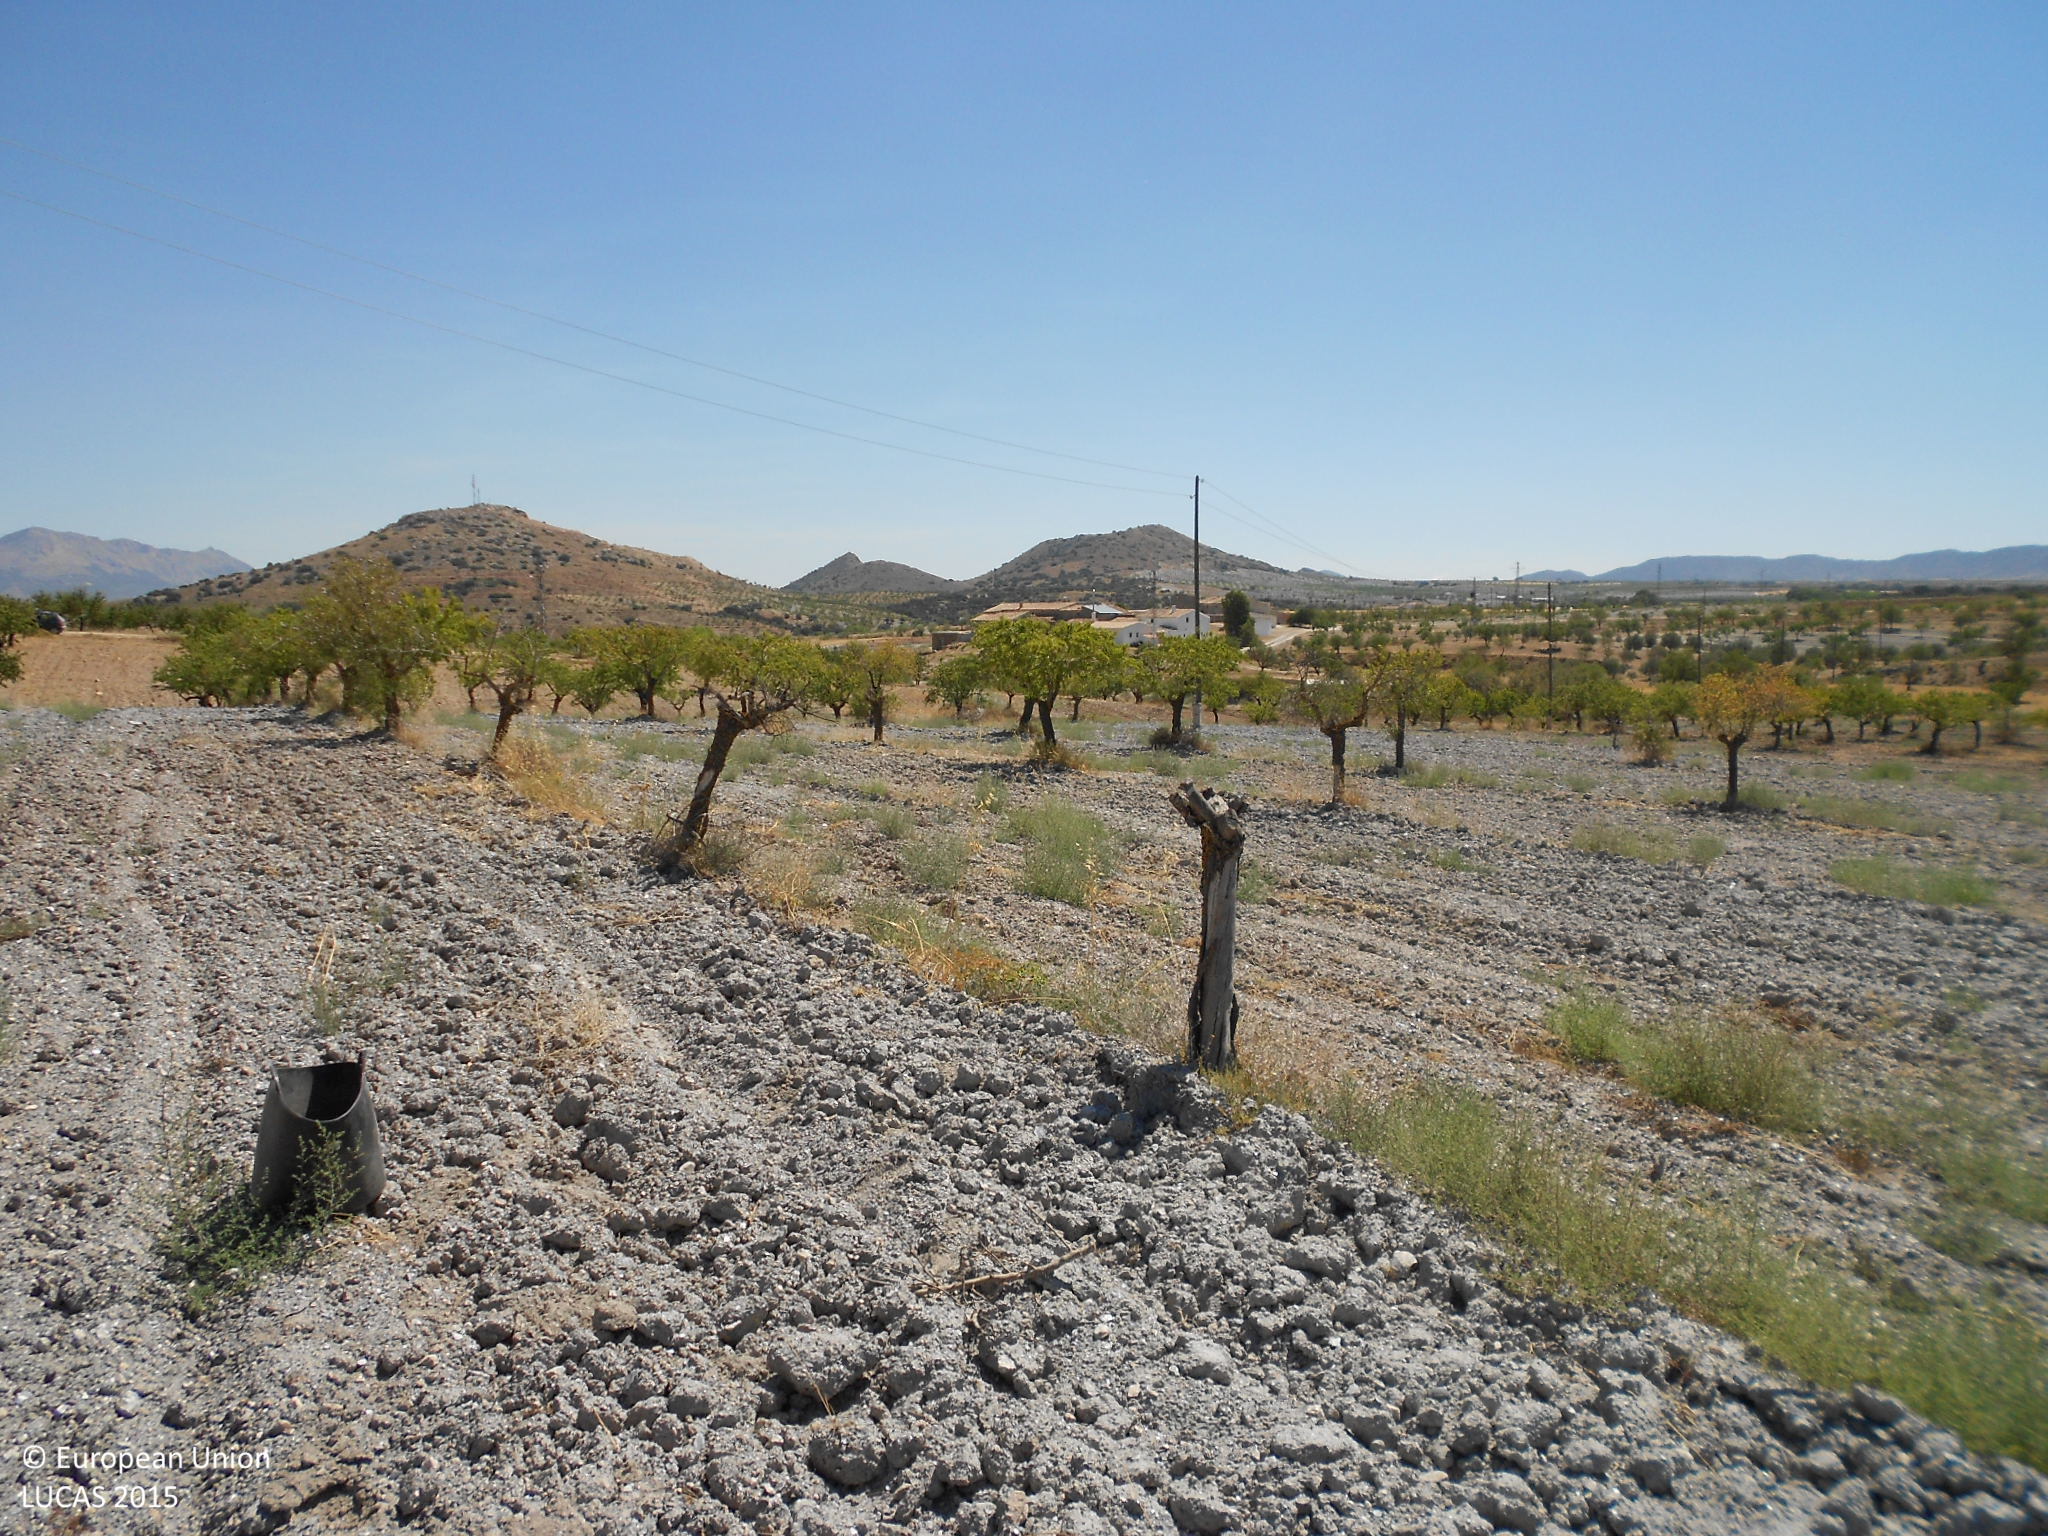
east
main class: Cropland
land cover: Nuts trees
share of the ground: < 10 %
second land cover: Other bare soil
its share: > 75 %
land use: Agriculture (excluding fallow land and kitchen gardens)
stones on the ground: > 50 %
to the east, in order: Nuts trees; Other bare soil; Electric lines; Nuts trees; Shrubland without tree cover; Tracks; Inland fresh running water; Shrubland without tree cover; Spontaneously vegetated surfaces; Tracks; Olive groves
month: July
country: ES
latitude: 37.5756
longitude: -2.2473
